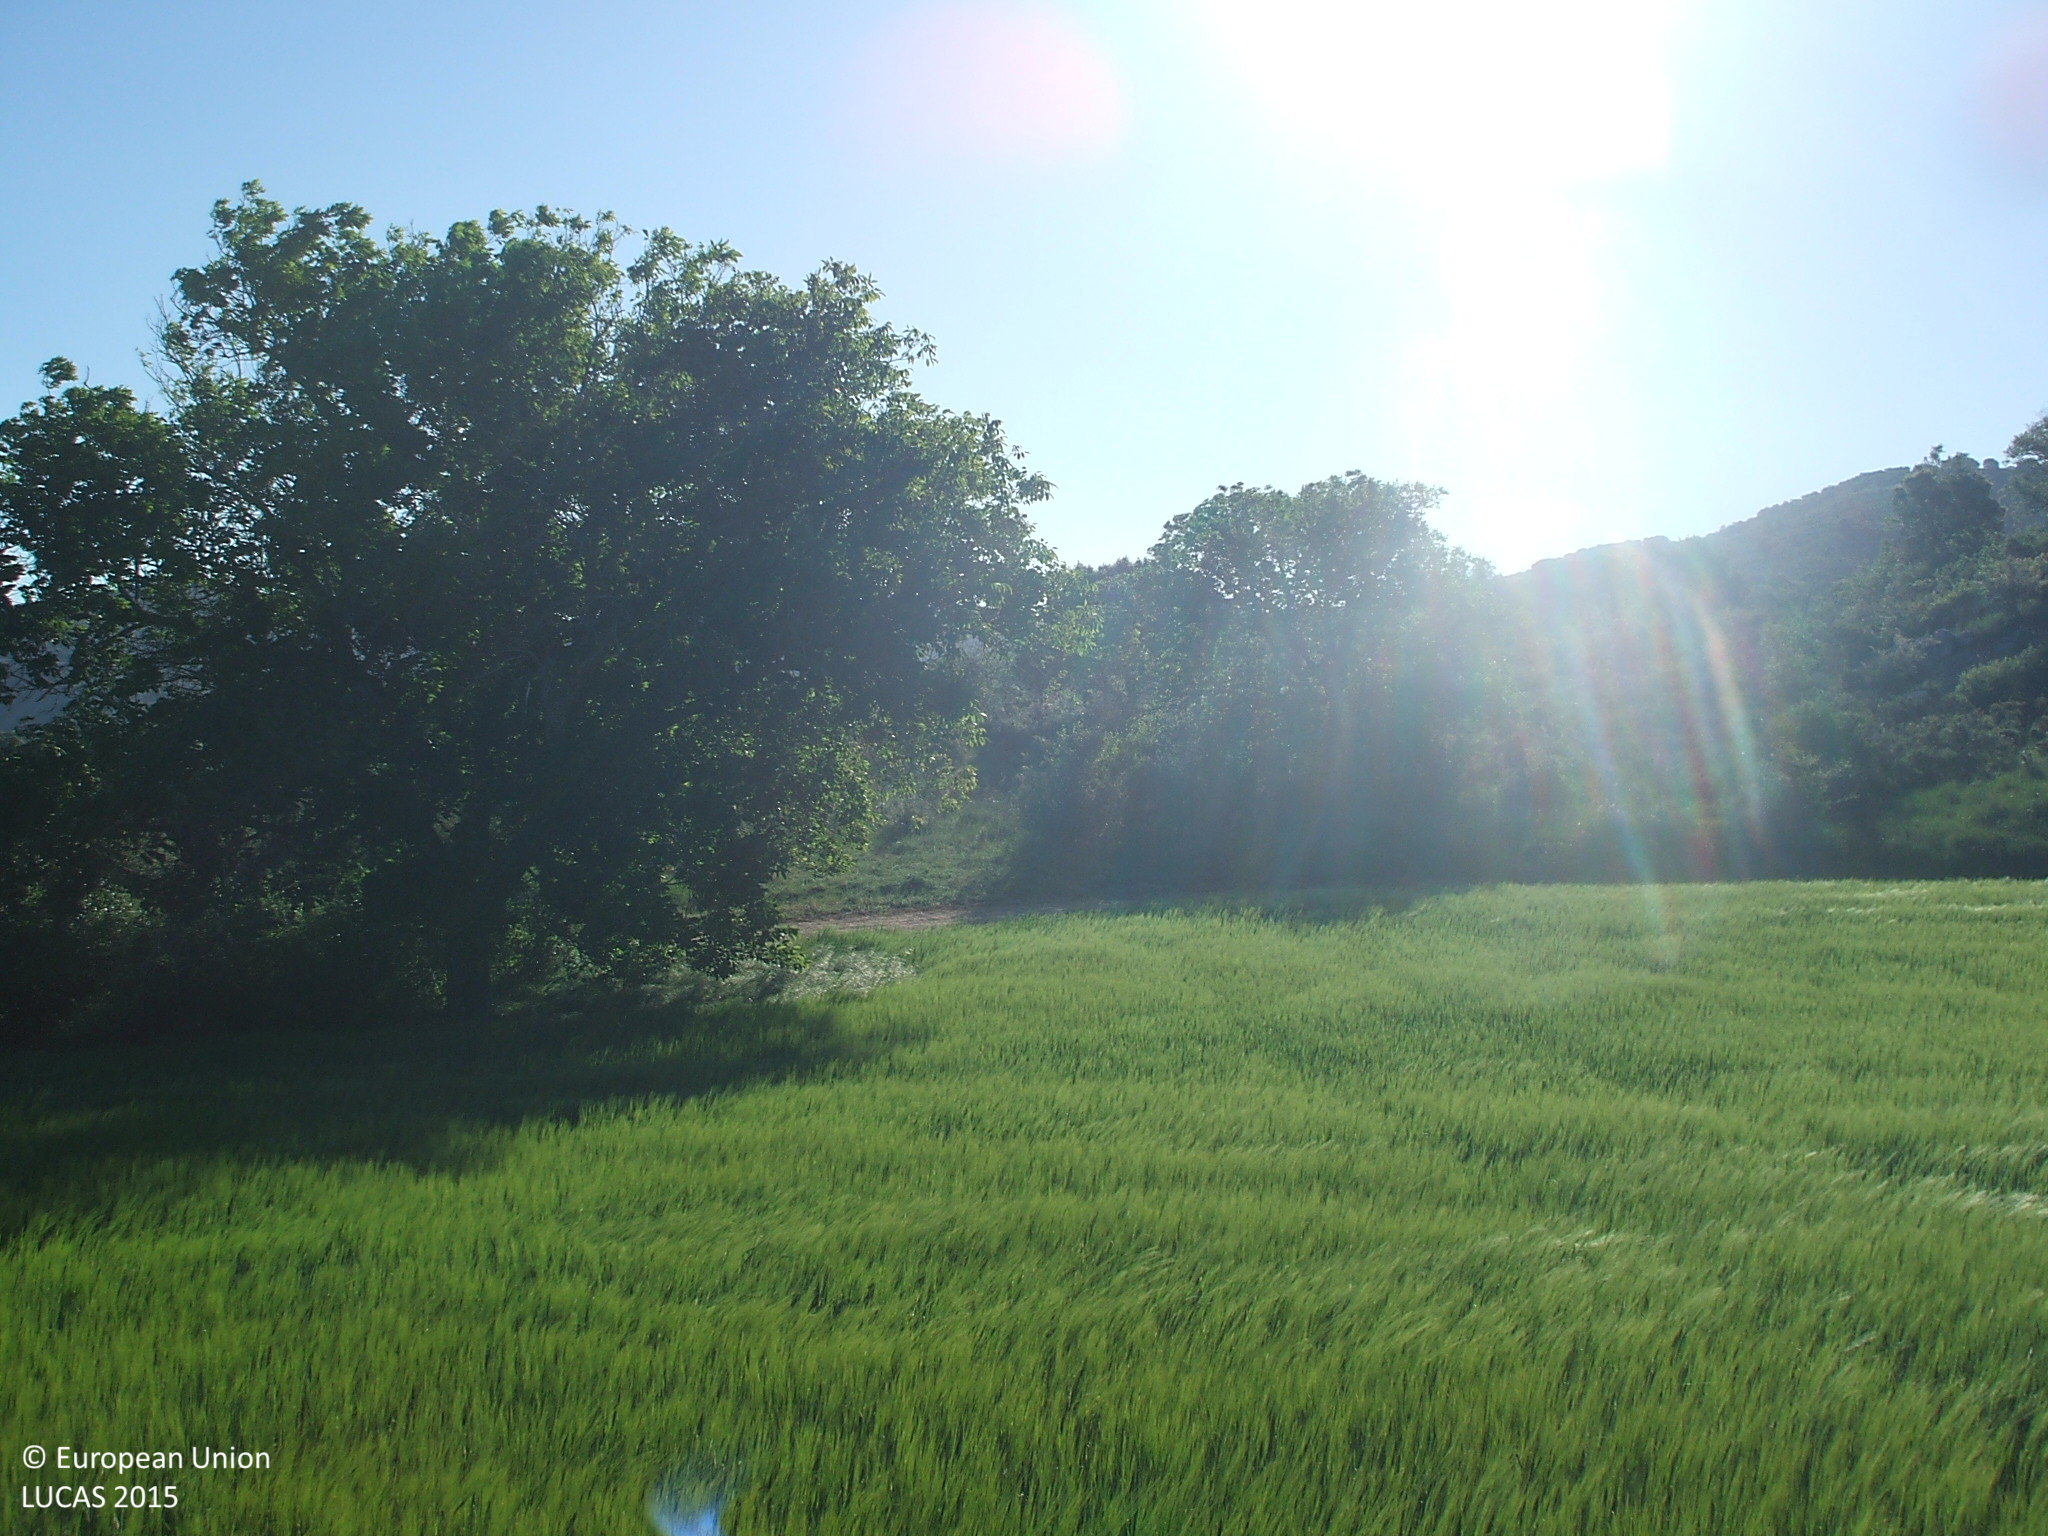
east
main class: Cropland
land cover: Barley
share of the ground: > 75 %
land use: Agriculture (excluding fallow land and kitchen gardens)
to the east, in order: Barley; Tracks; Shrubland with sparse tree cover; Barley
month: May
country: ES
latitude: 40.7525
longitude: -2.8586
